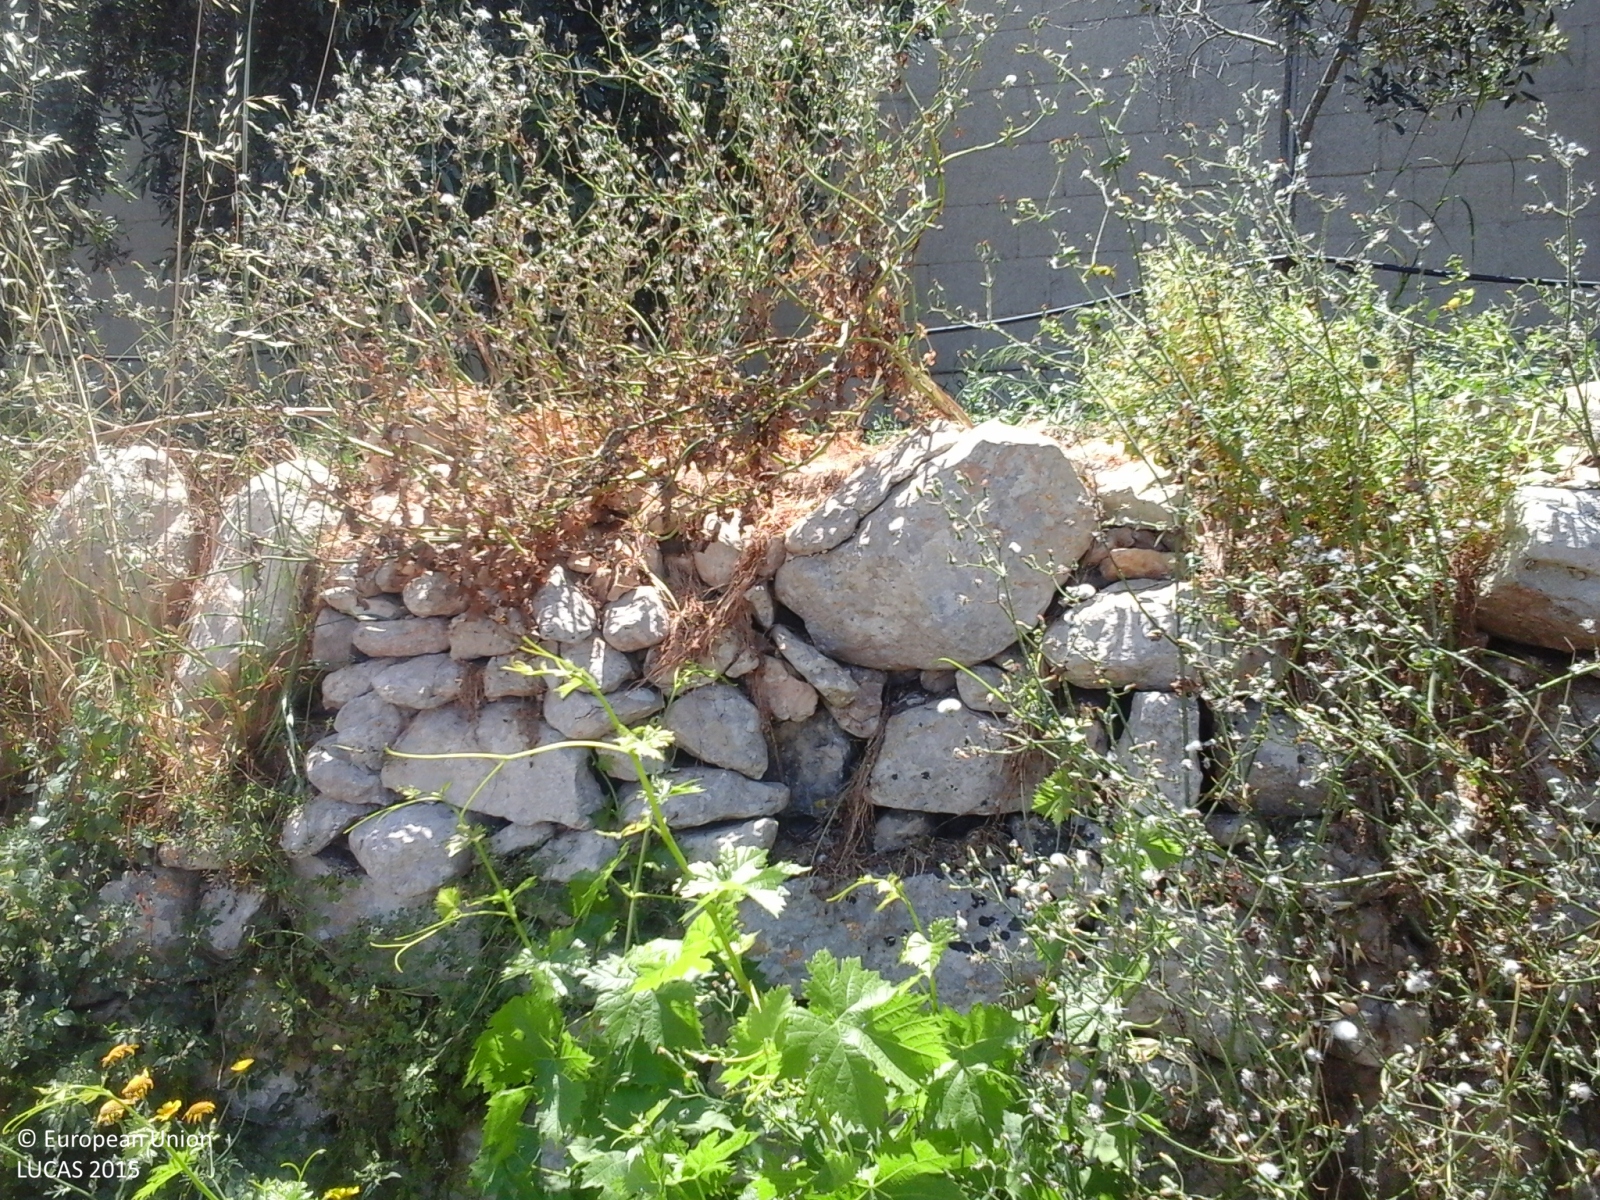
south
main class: Cropland
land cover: Olive groves
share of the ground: 10 - 25 %
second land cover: Spontaneously vegetated surfaces
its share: 10 - 25 %
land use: Agriculture (excluding fallow land and kitchen gardens)
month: May
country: MT
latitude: 35.8218
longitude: 14.4852
